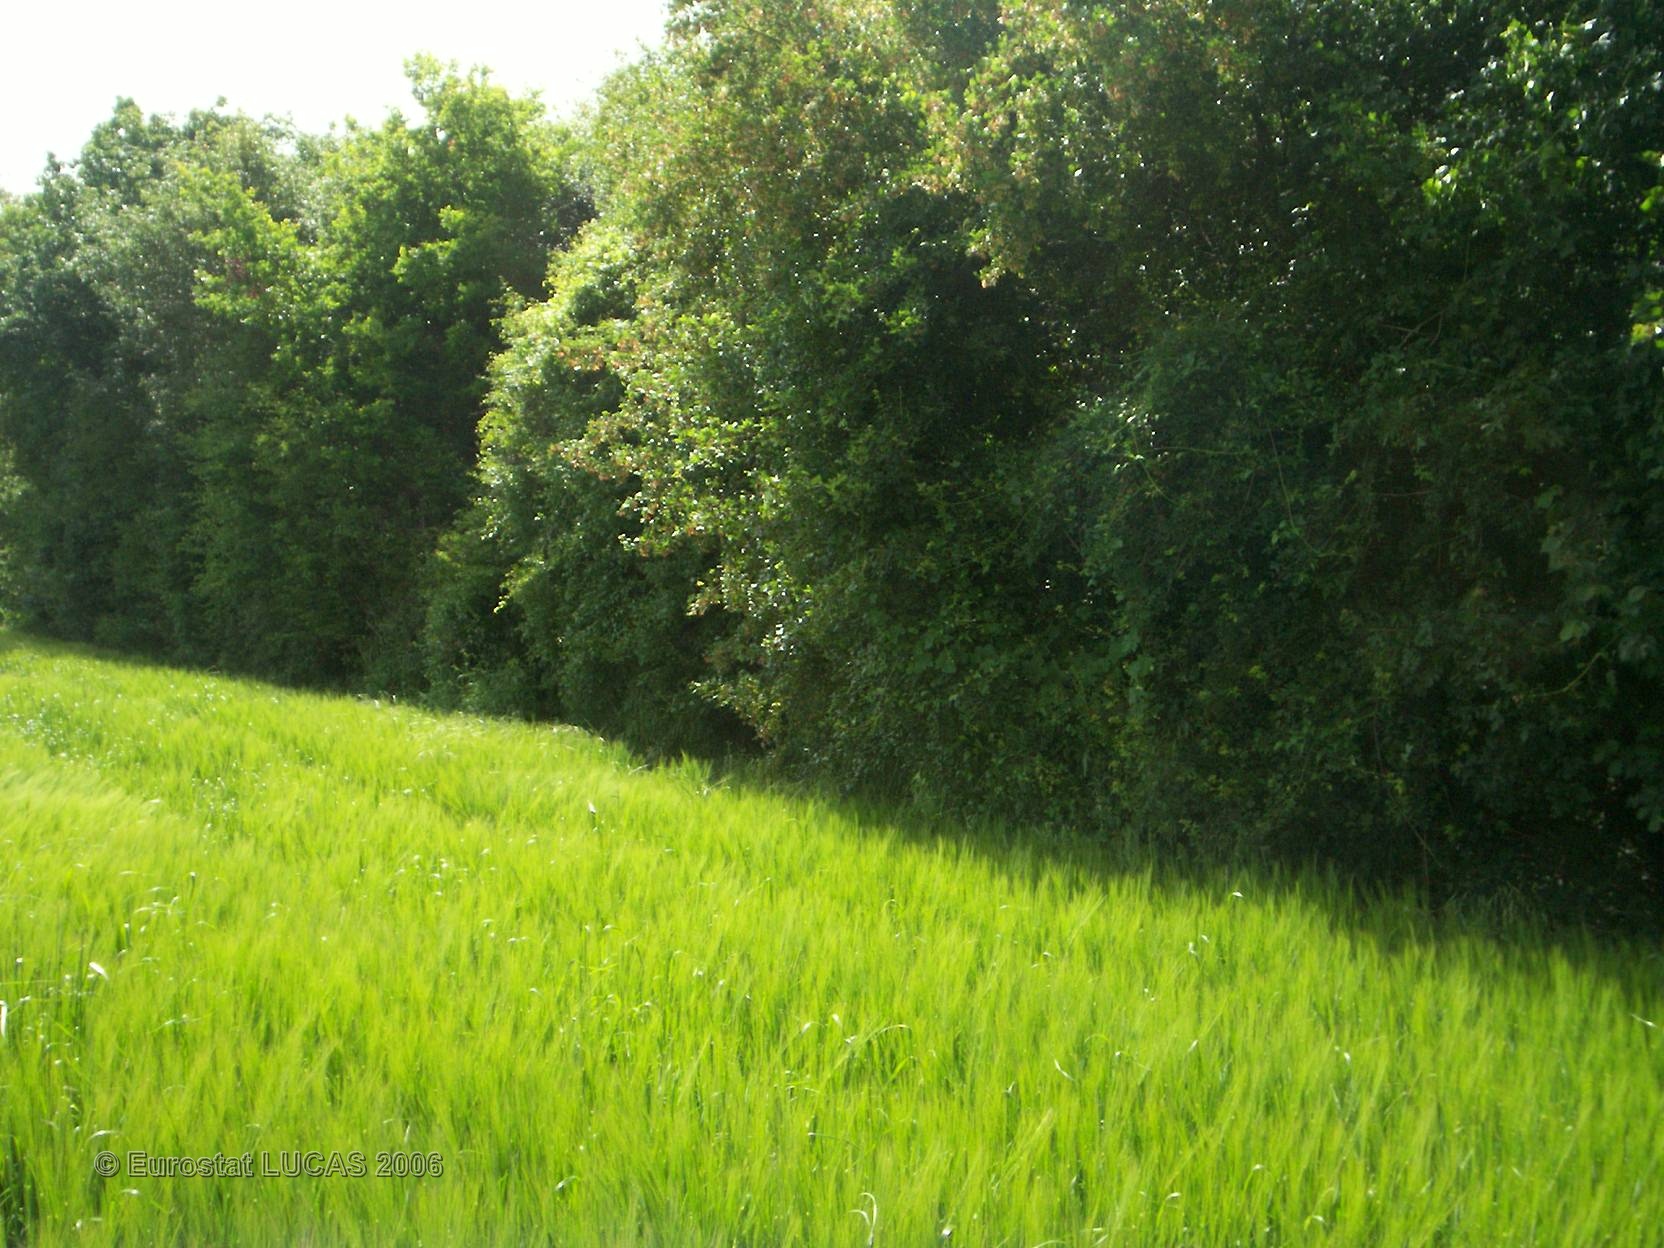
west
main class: Cropland
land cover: Barley
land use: Agriculture (excluding fallow land and kitchen gardens)
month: May
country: FR
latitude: 45.7497
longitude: -0.7850
